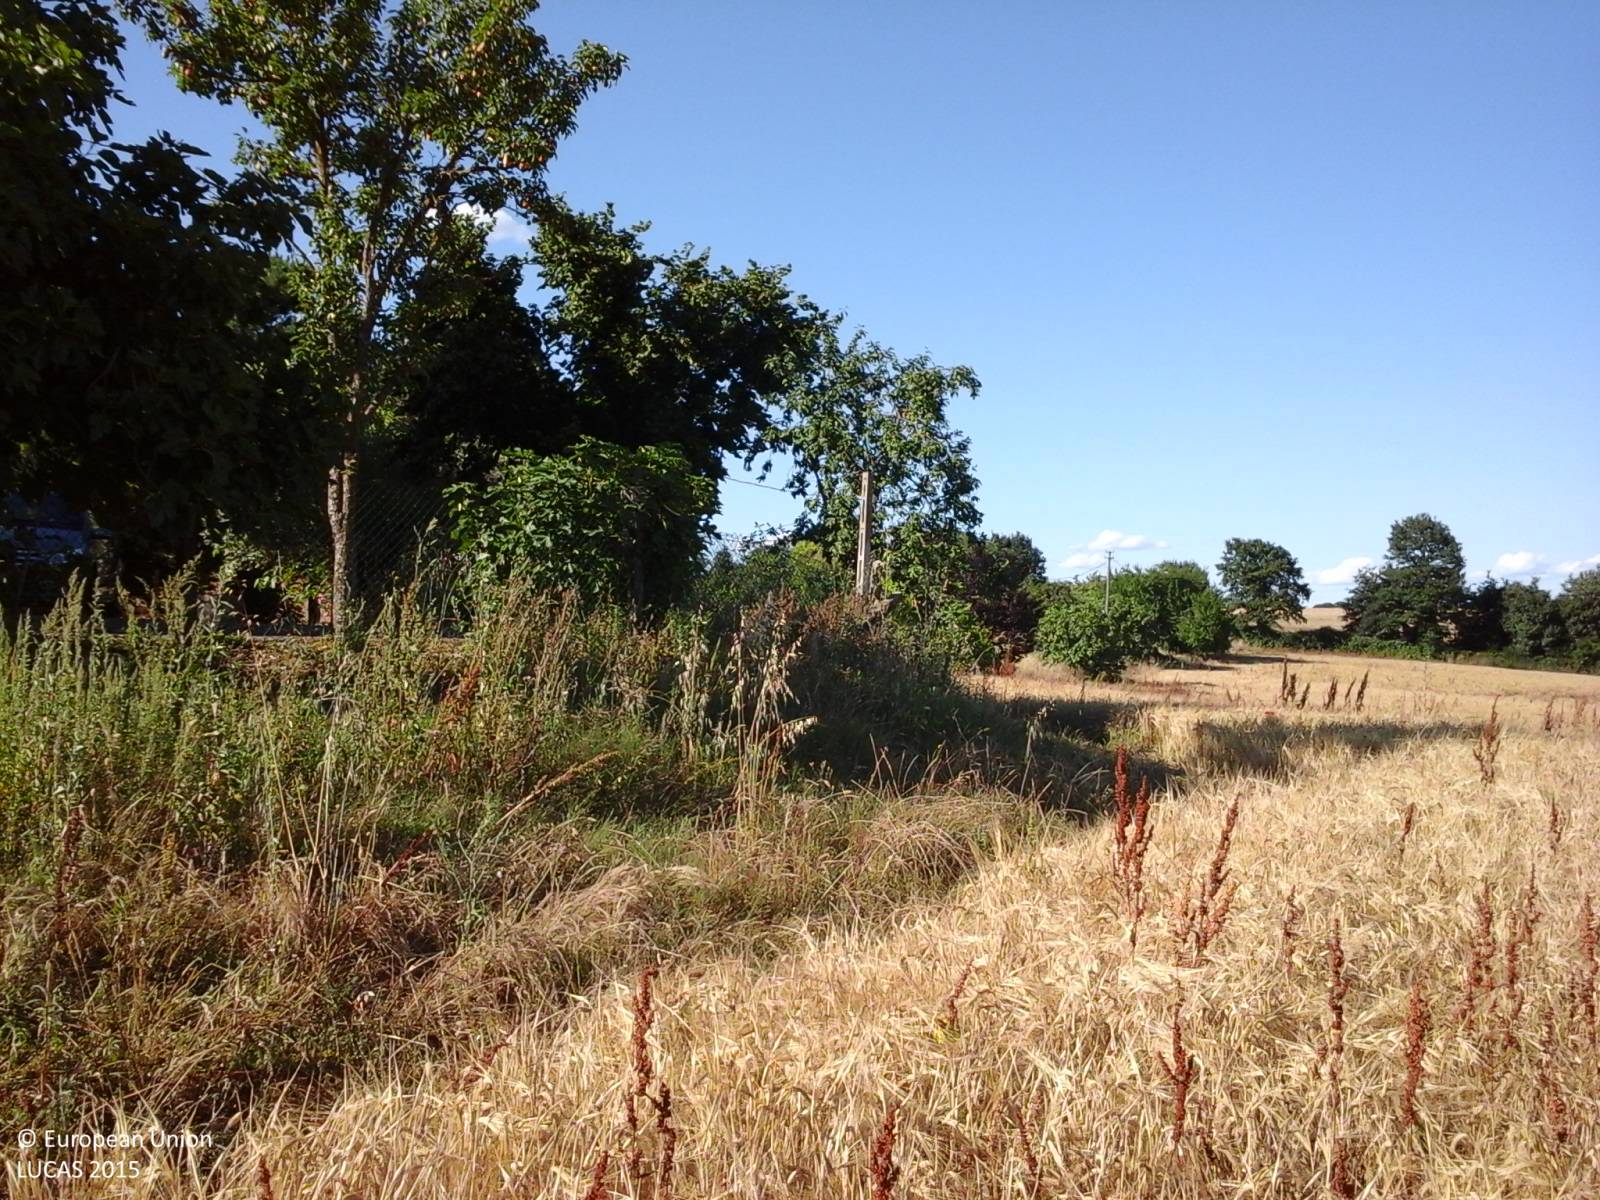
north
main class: Cropland
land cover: Barley
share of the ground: > 75 %
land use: Agriculture (excluding fallow land and kitchen gardens)
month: June
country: IT
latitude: 42.4469
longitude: 12.3144
